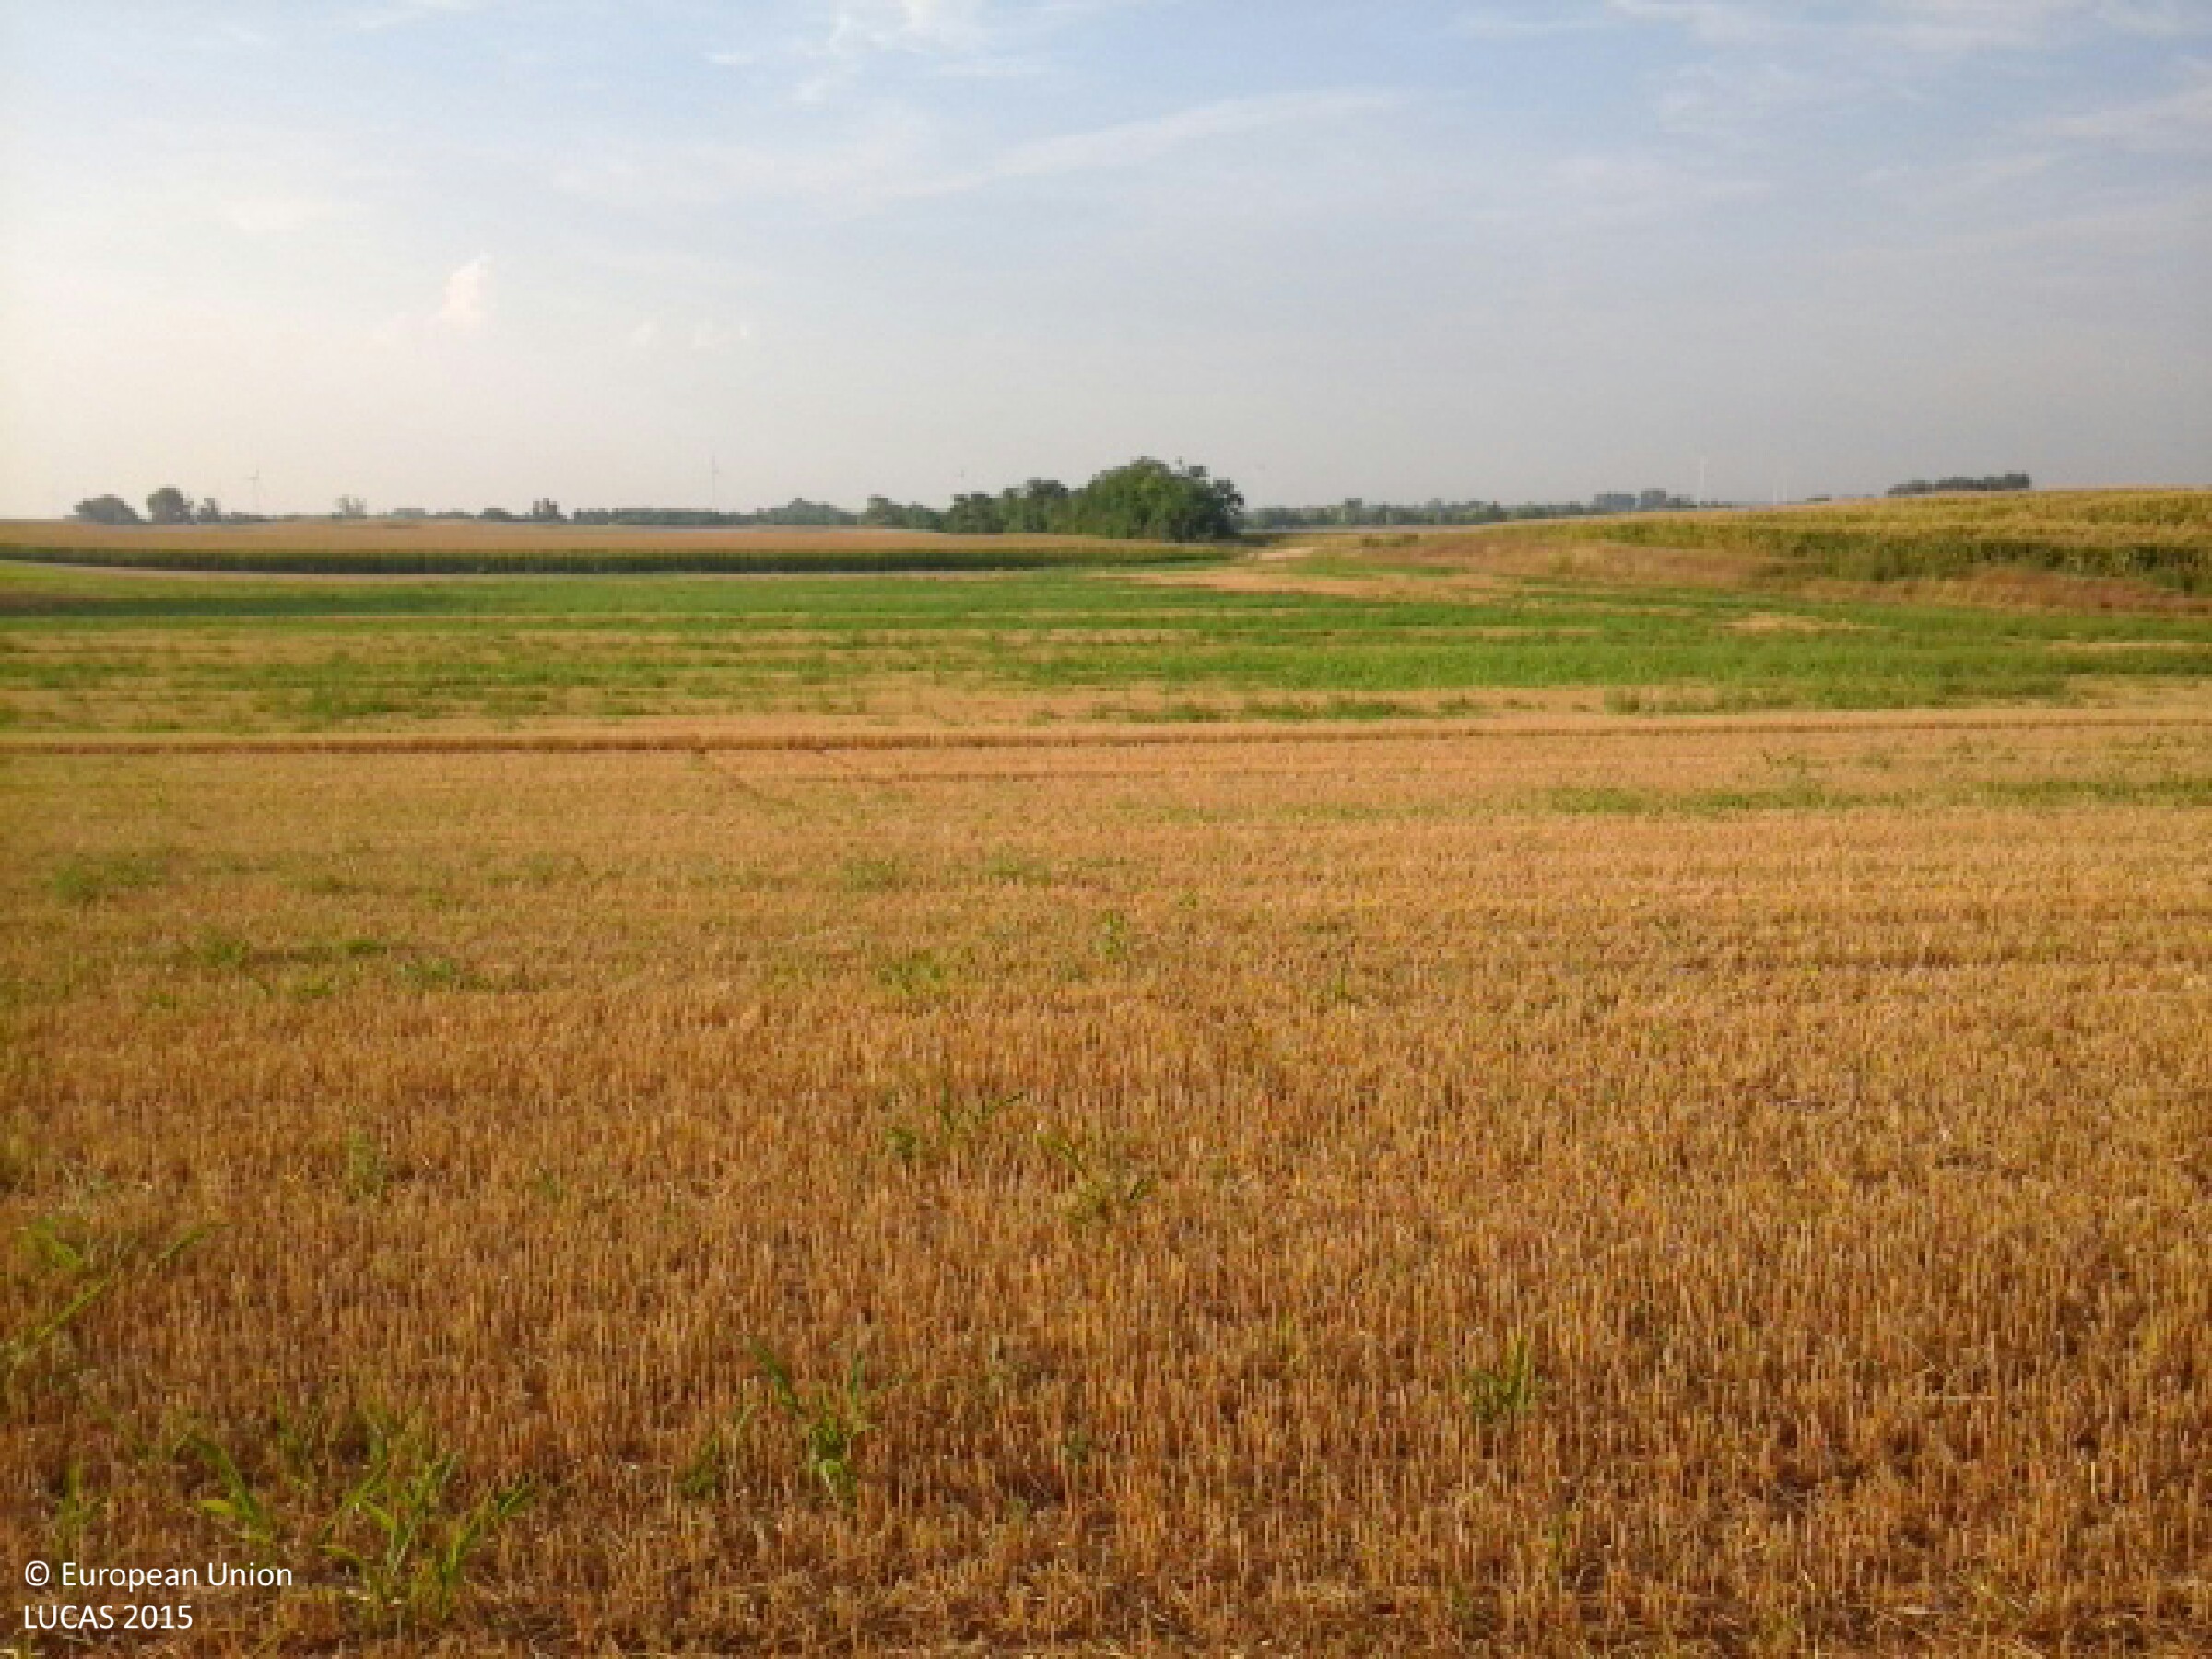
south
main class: Cropland
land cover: Triticale
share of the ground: 10 - 25 %
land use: Agriculture (excluding fallow land and kitchen gardens)
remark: Harvested field
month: August
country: HU
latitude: 47.7197
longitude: 17.9429
